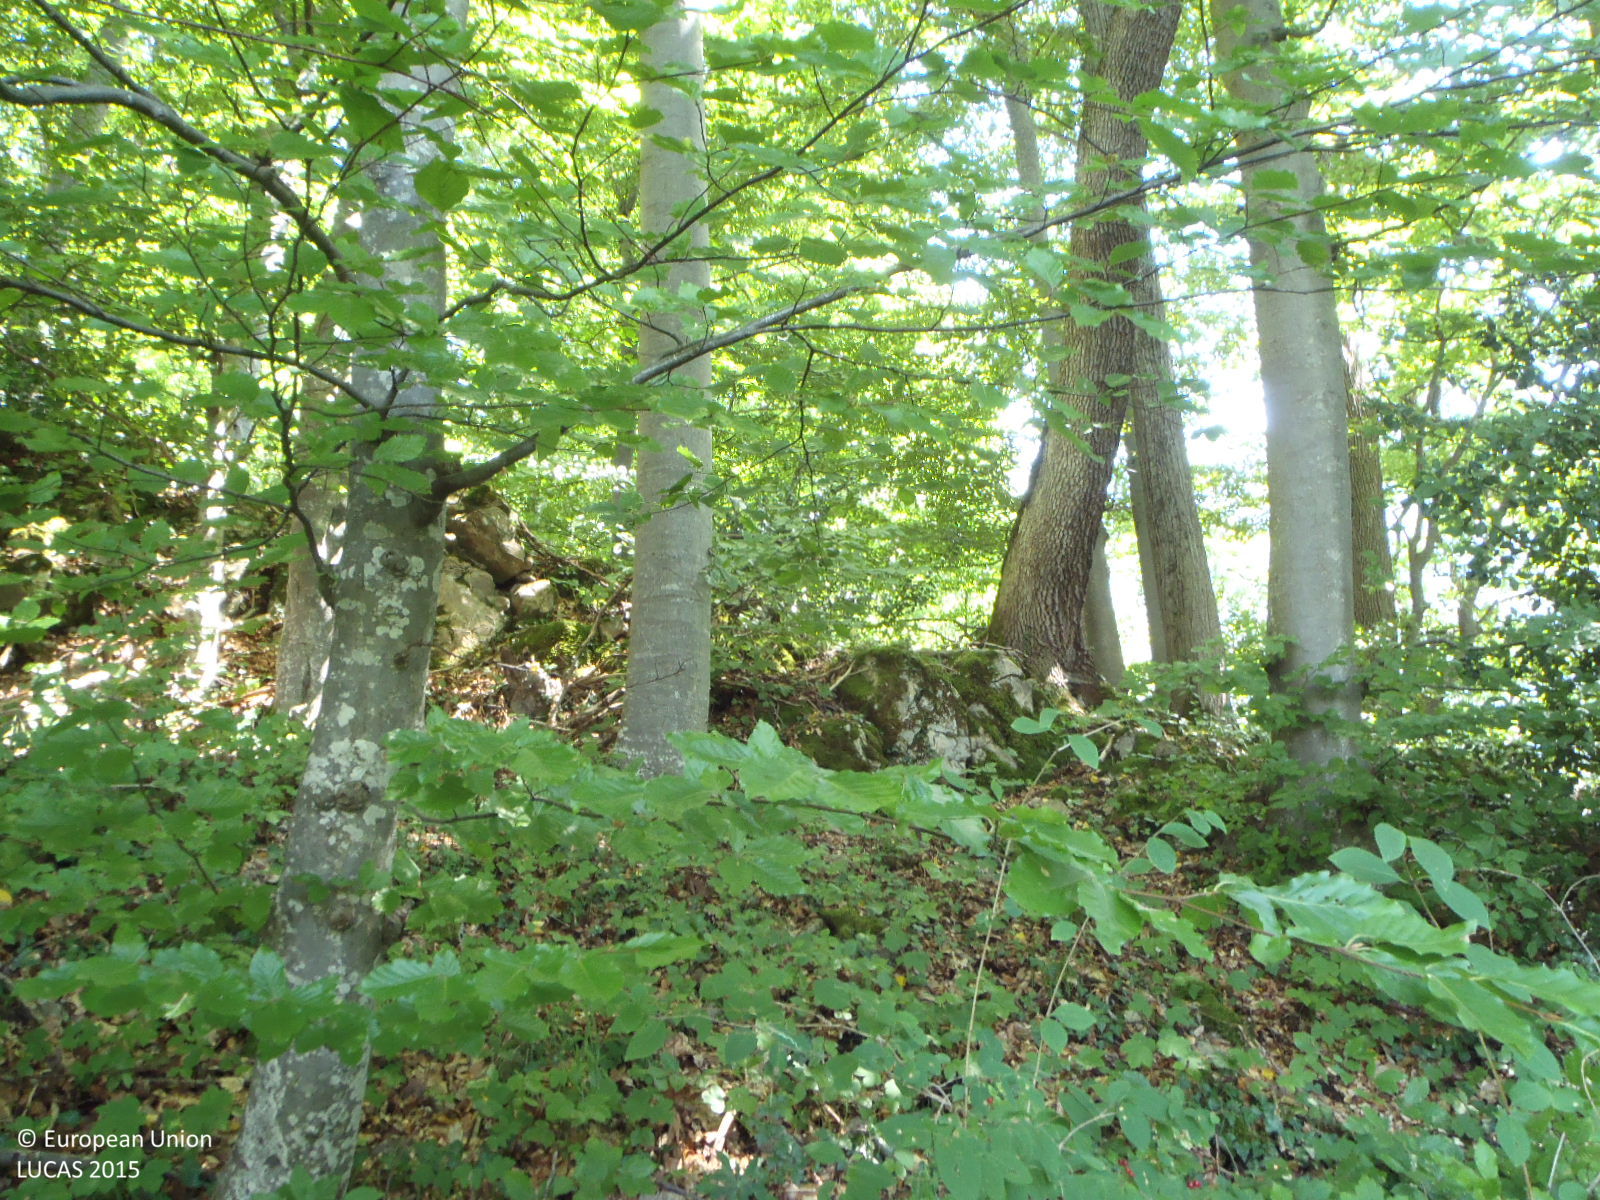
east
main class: Woodland
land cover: Broadleaved woodland
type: mountainous beech forest
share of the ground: > 75 %
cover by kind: broadleaved forest trees 80 %, coniferous forest trees 10 %, herbaceous plants 10 %
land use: Forestry
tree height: > 5 m
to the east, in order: Broadleaved woodland; Fences; Shrubland without tree cover; Broadleaved woodland; Fences; Broadleaved woodland; Shrubland without tree cover; Fences; Grassland without tree/shrub cover; Apple fruit
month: July
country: AT
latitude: 47.3411
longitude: 9.6694
